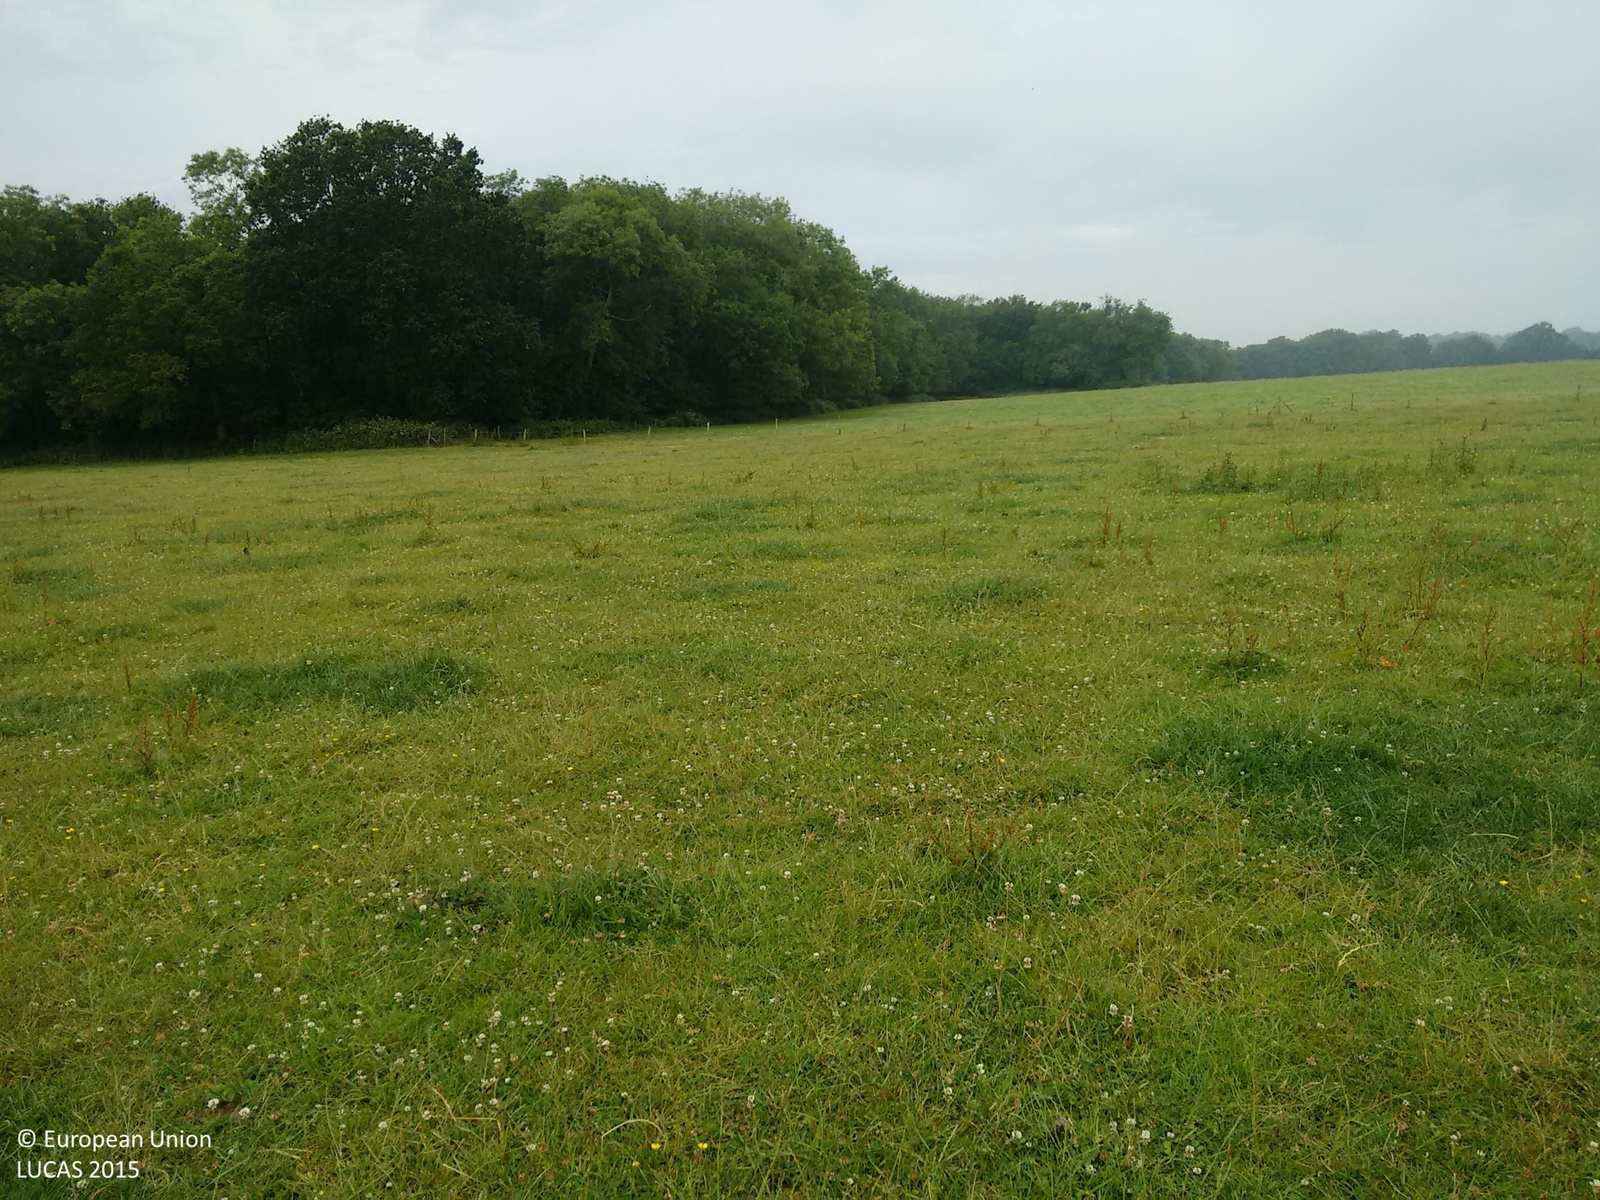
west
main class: Grassland
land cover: Grassland without tree/shrub cover
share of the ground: > 75 %
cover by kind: herbaceous plants 100 %
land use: Agriculture (excluding fallow land and kitchen gardens)
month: July
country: GB
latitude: 51.0533
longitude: -0.1491
